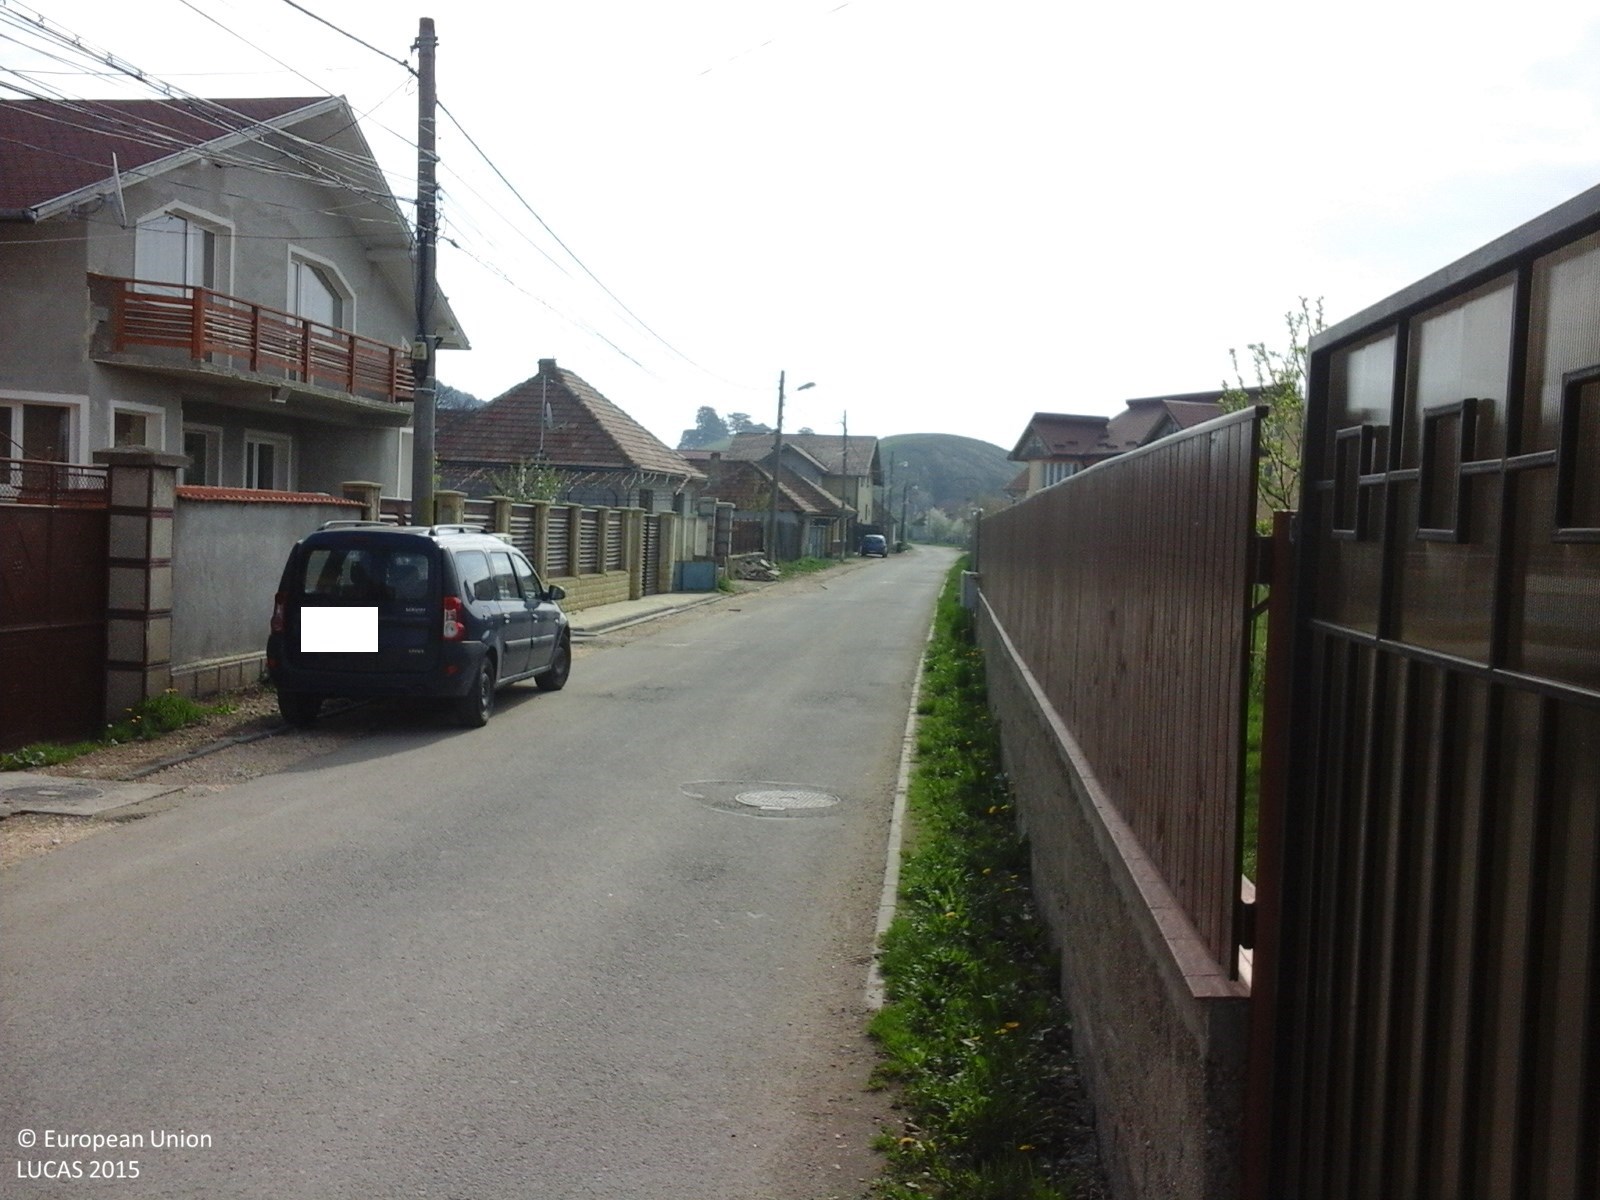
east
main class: Grassland
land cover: Grassland without tree/shrub cover
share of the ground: > 75 %
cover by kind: herbaceous plants 100 %
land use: Agriculture (excluding fallow land and kitchen gardens)
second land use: Residential
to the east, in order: Grassland without tree/shrub cover; Artificial constructions in urban areas
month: May
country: RO
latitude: 45.7058
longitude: 25.6348
